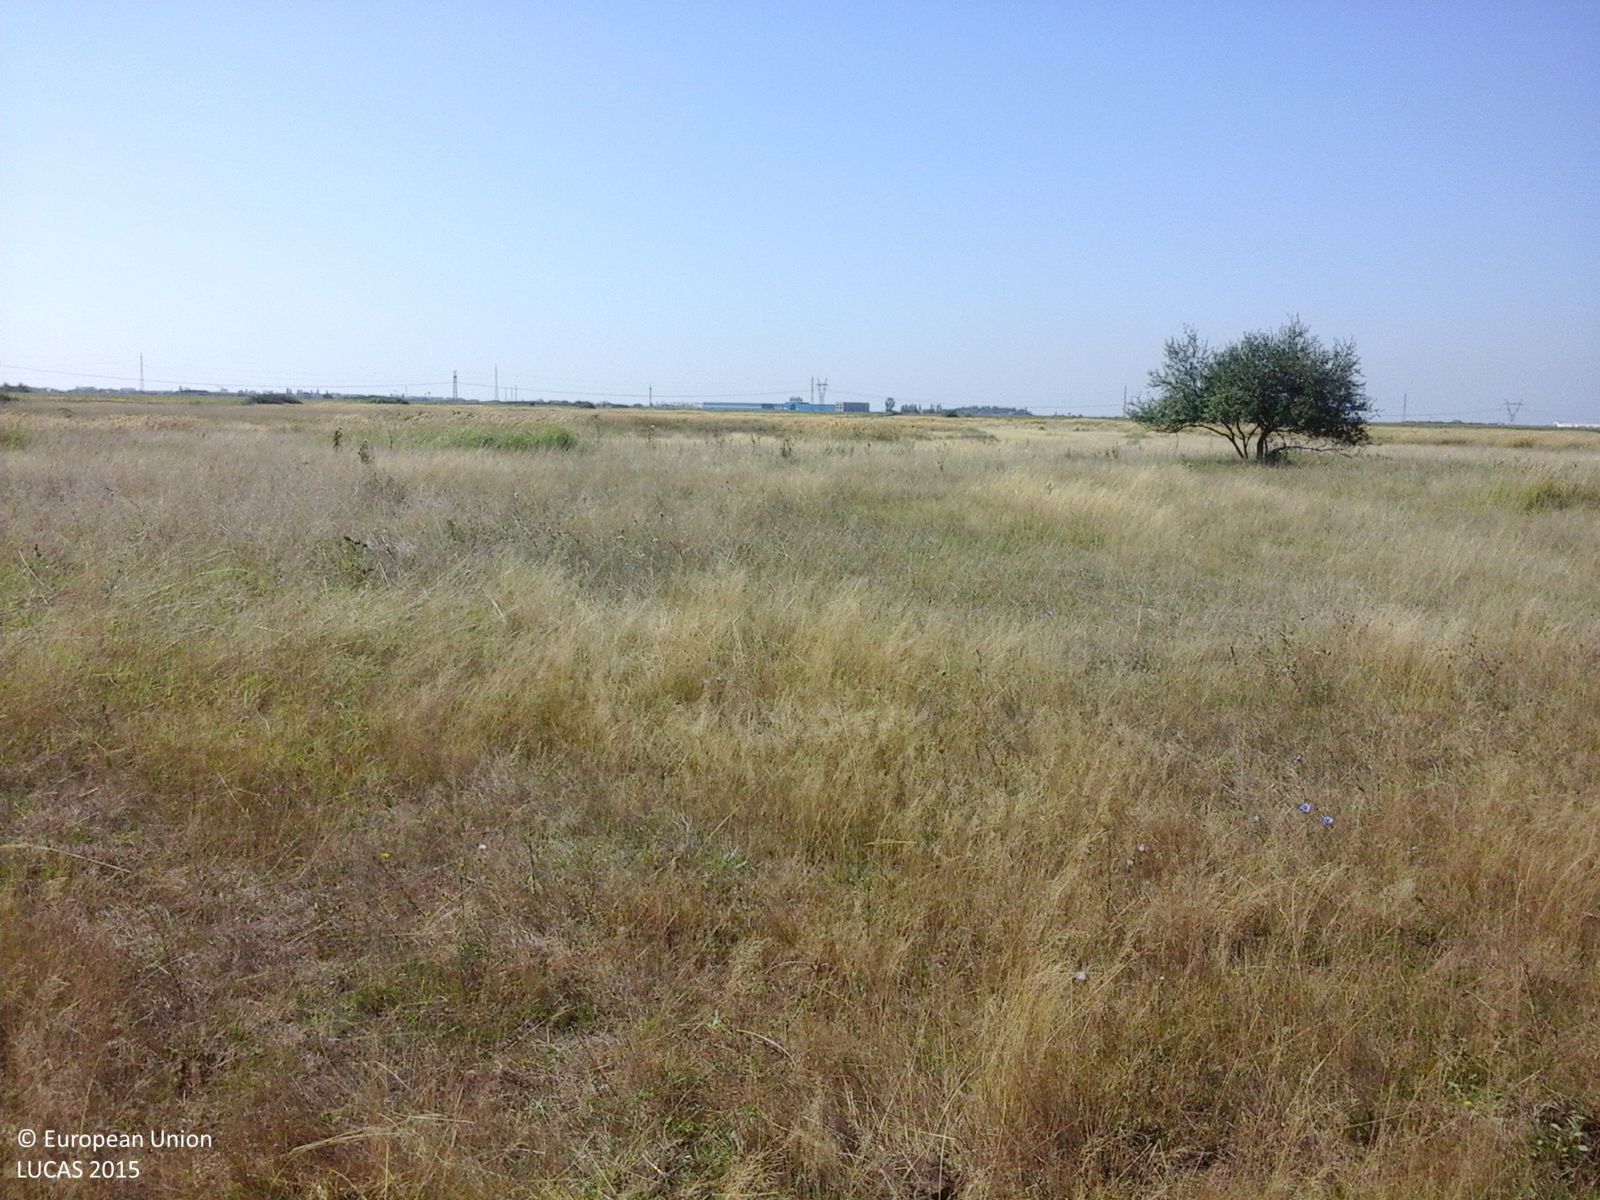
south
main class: Grassland
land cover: Grassland without tree/shrub cover
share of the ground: > 75 %
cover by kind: herbaceous plants 100 %
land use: Agriculture (excluding fallow land and kitchen gardens)
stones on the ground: < 10 %
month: August
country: RO
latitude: 45.8318
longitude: 21.2179
